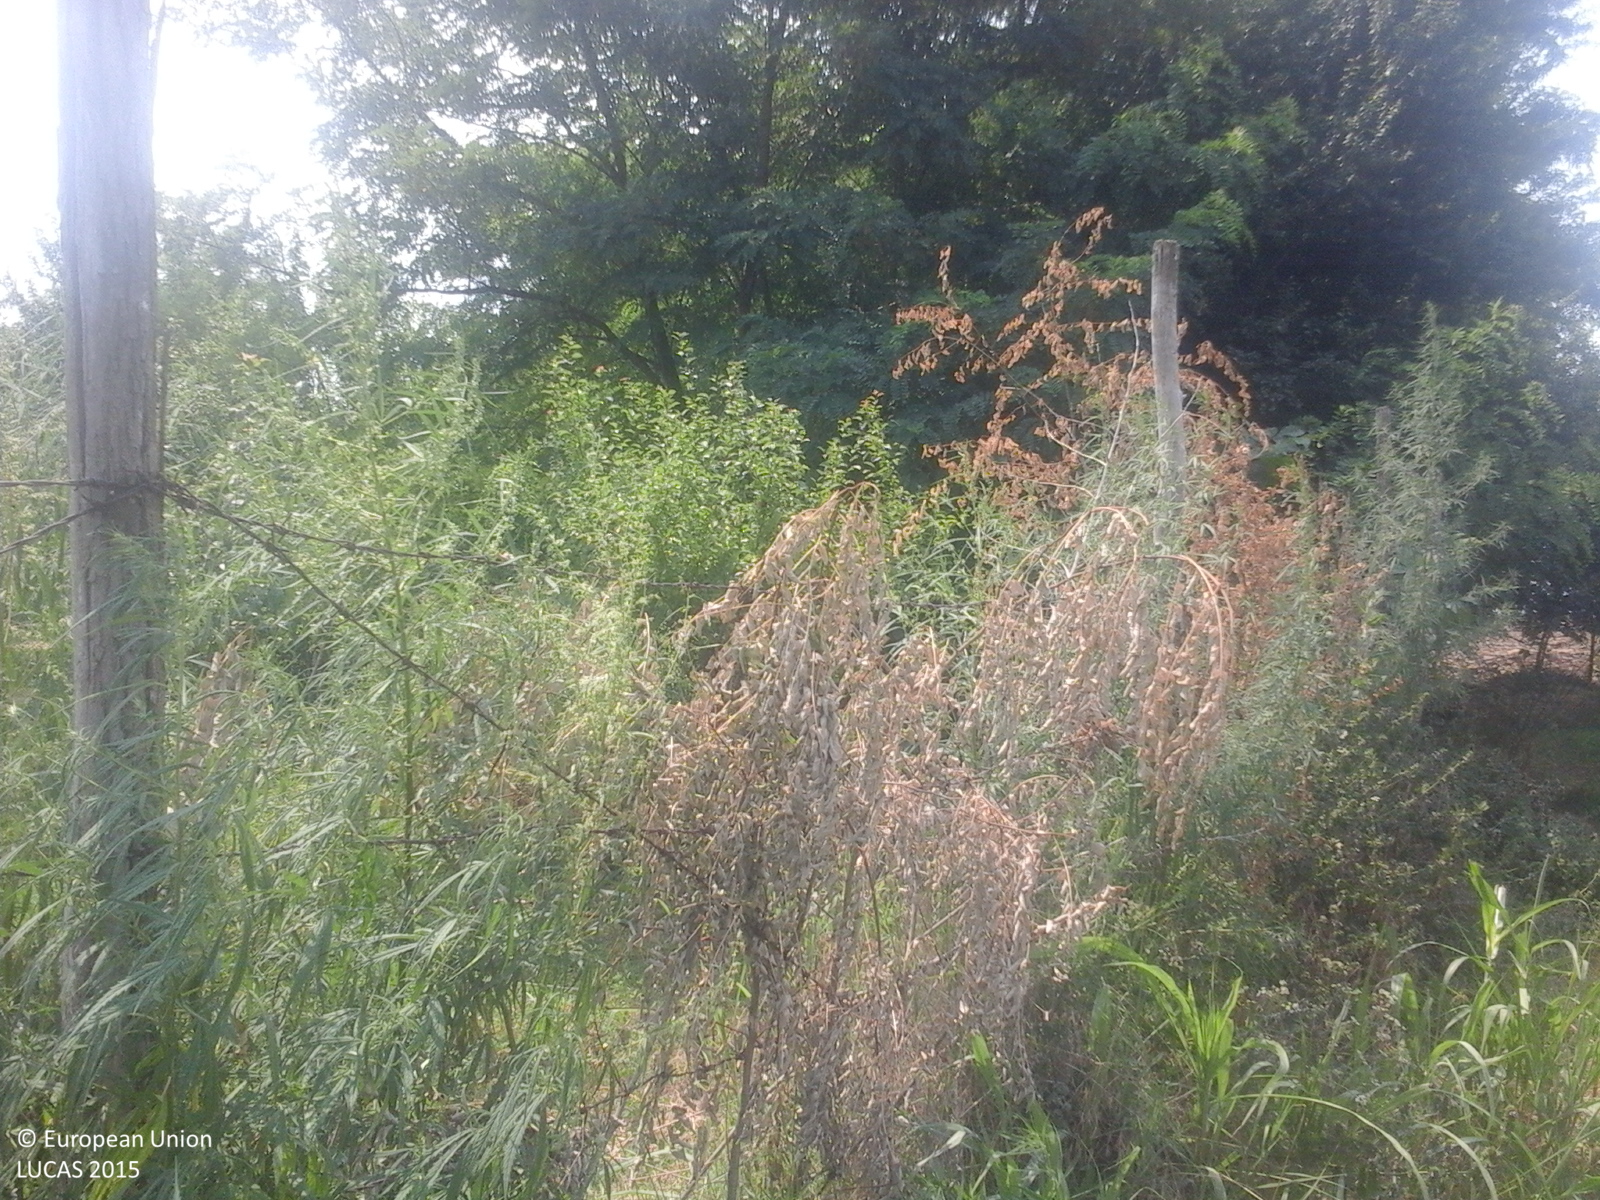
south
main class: Cropland
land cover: Lucerne
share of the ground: > 75 %
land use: Agriculture (excluding fallow land and kitchen gardens)
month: July
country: RO
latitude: 44.7698
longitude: 26.3511
